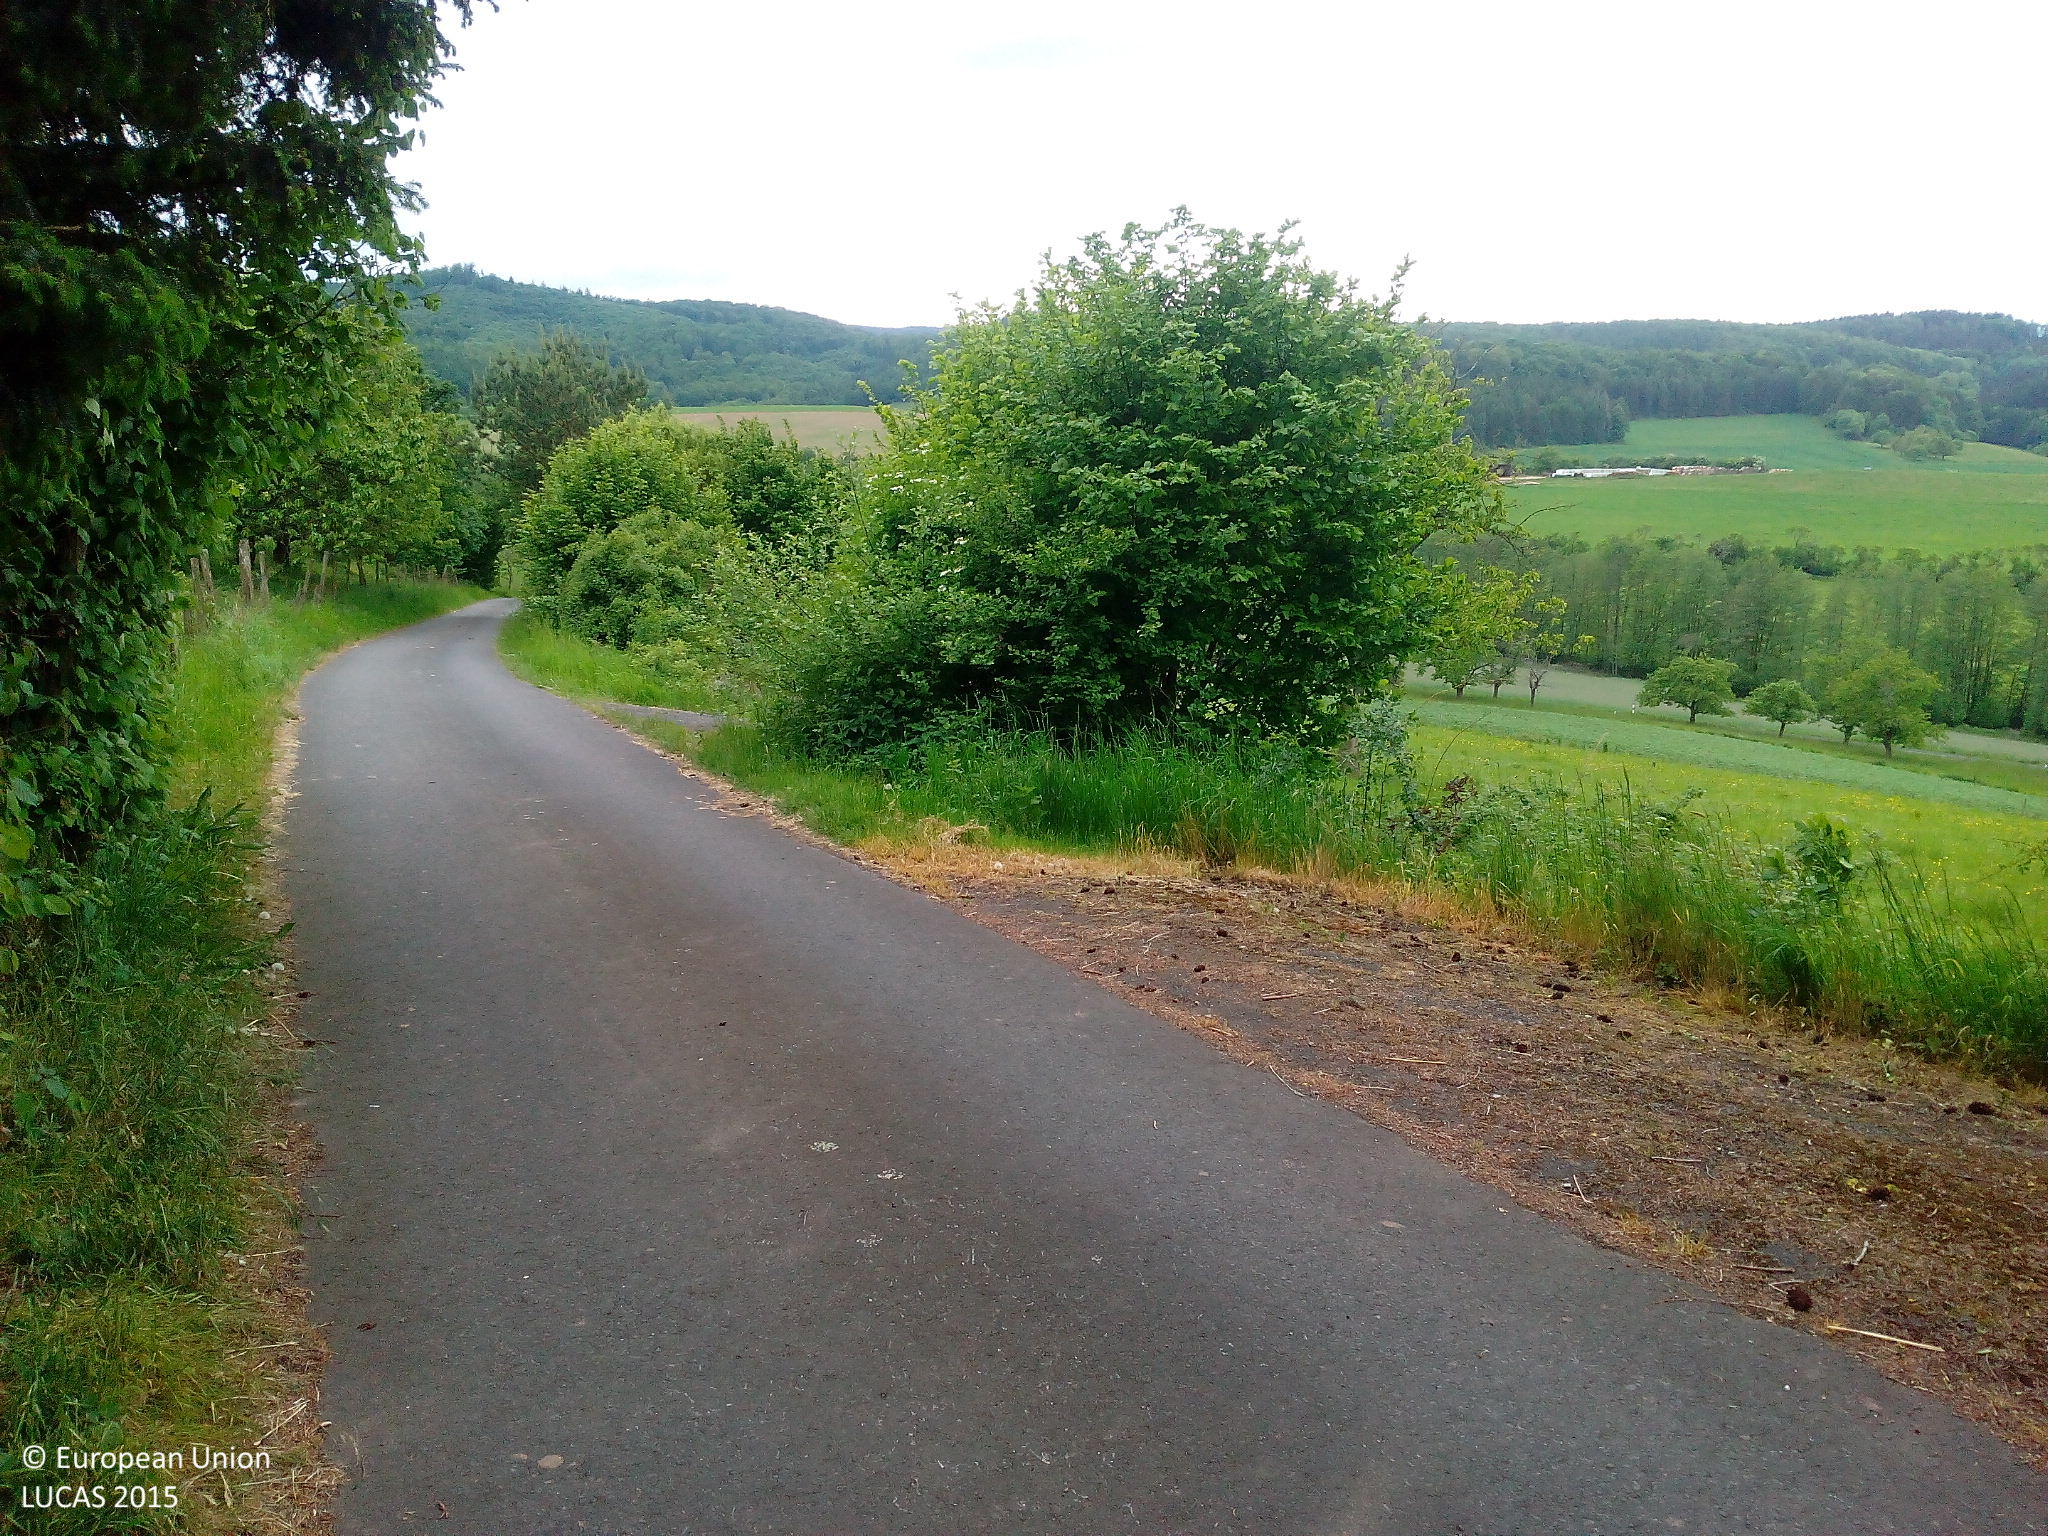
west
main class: Cropland
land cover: Cherry fruit
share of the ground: 10 - 25 %
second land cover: Grassland without tree/shrub cover
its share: > 75 %
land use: Agriculture (excluding fallow land and kitchen gardens)
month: May
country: DE
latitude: 51.2988
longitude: 9.8423
